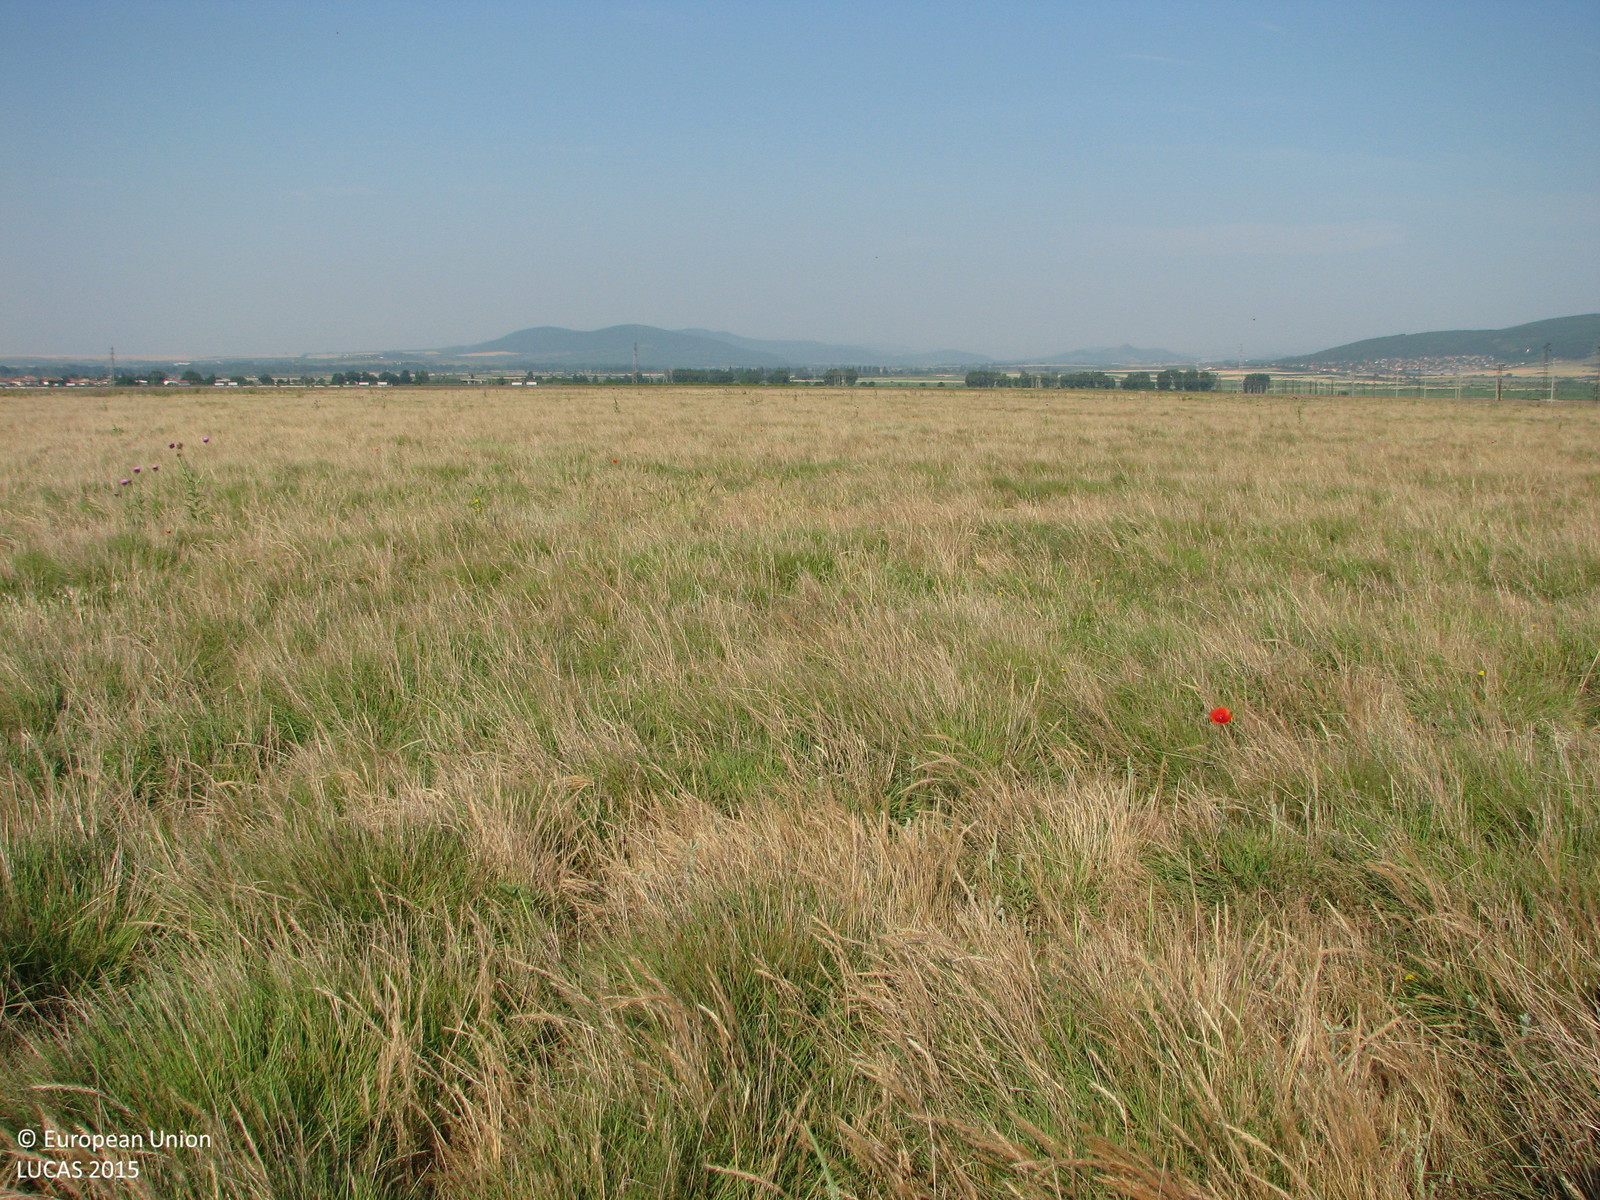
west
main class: Grassland
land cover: Grassland without tree/shrub cover
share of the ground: > 75 %
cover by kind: herbaceous plants 100 %
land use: Agriculture (excluding fallow land and kitchen gardens)
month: June
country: BG
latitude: 42.6470
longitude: 26.2995
